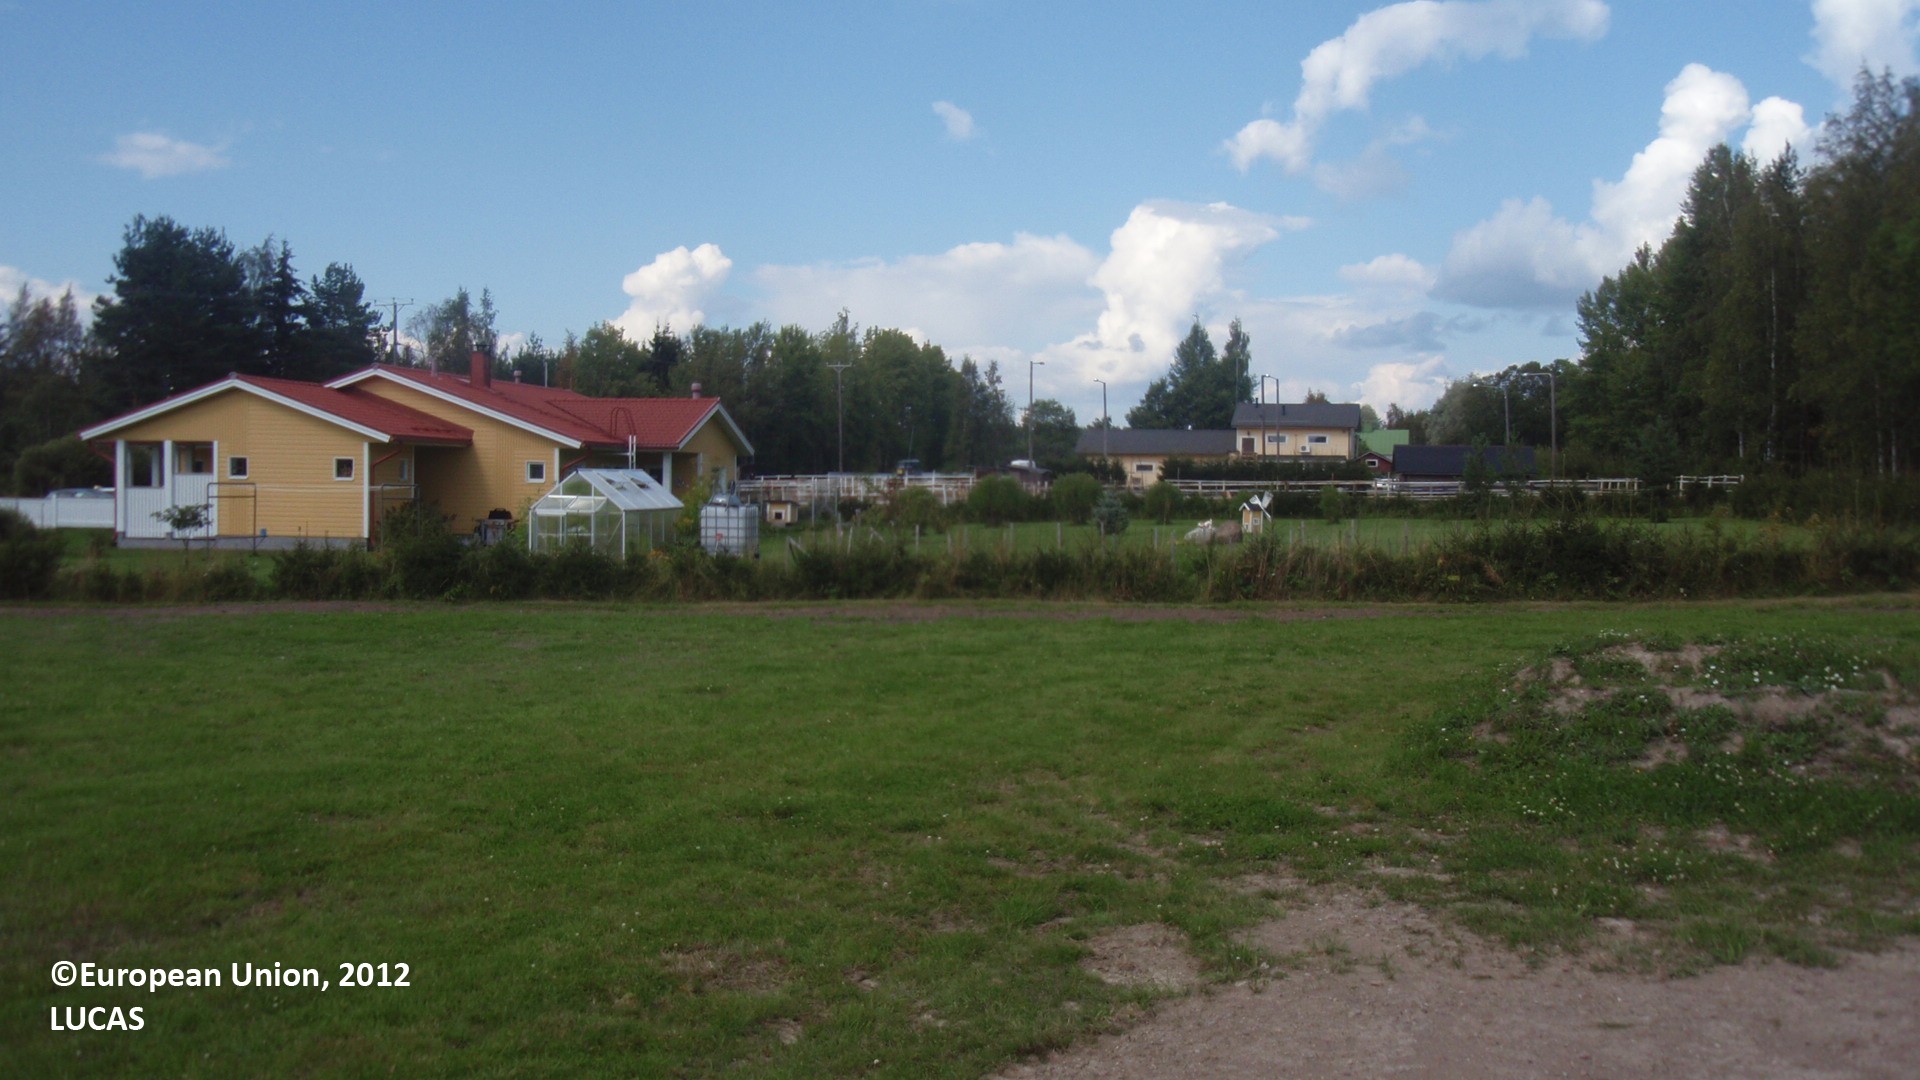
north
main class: Grassland
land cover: Grassland without tree/shrub cover
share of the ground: > 75 %
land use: Residential
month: August
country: FI
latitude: 60.9323
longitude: 26.6716
